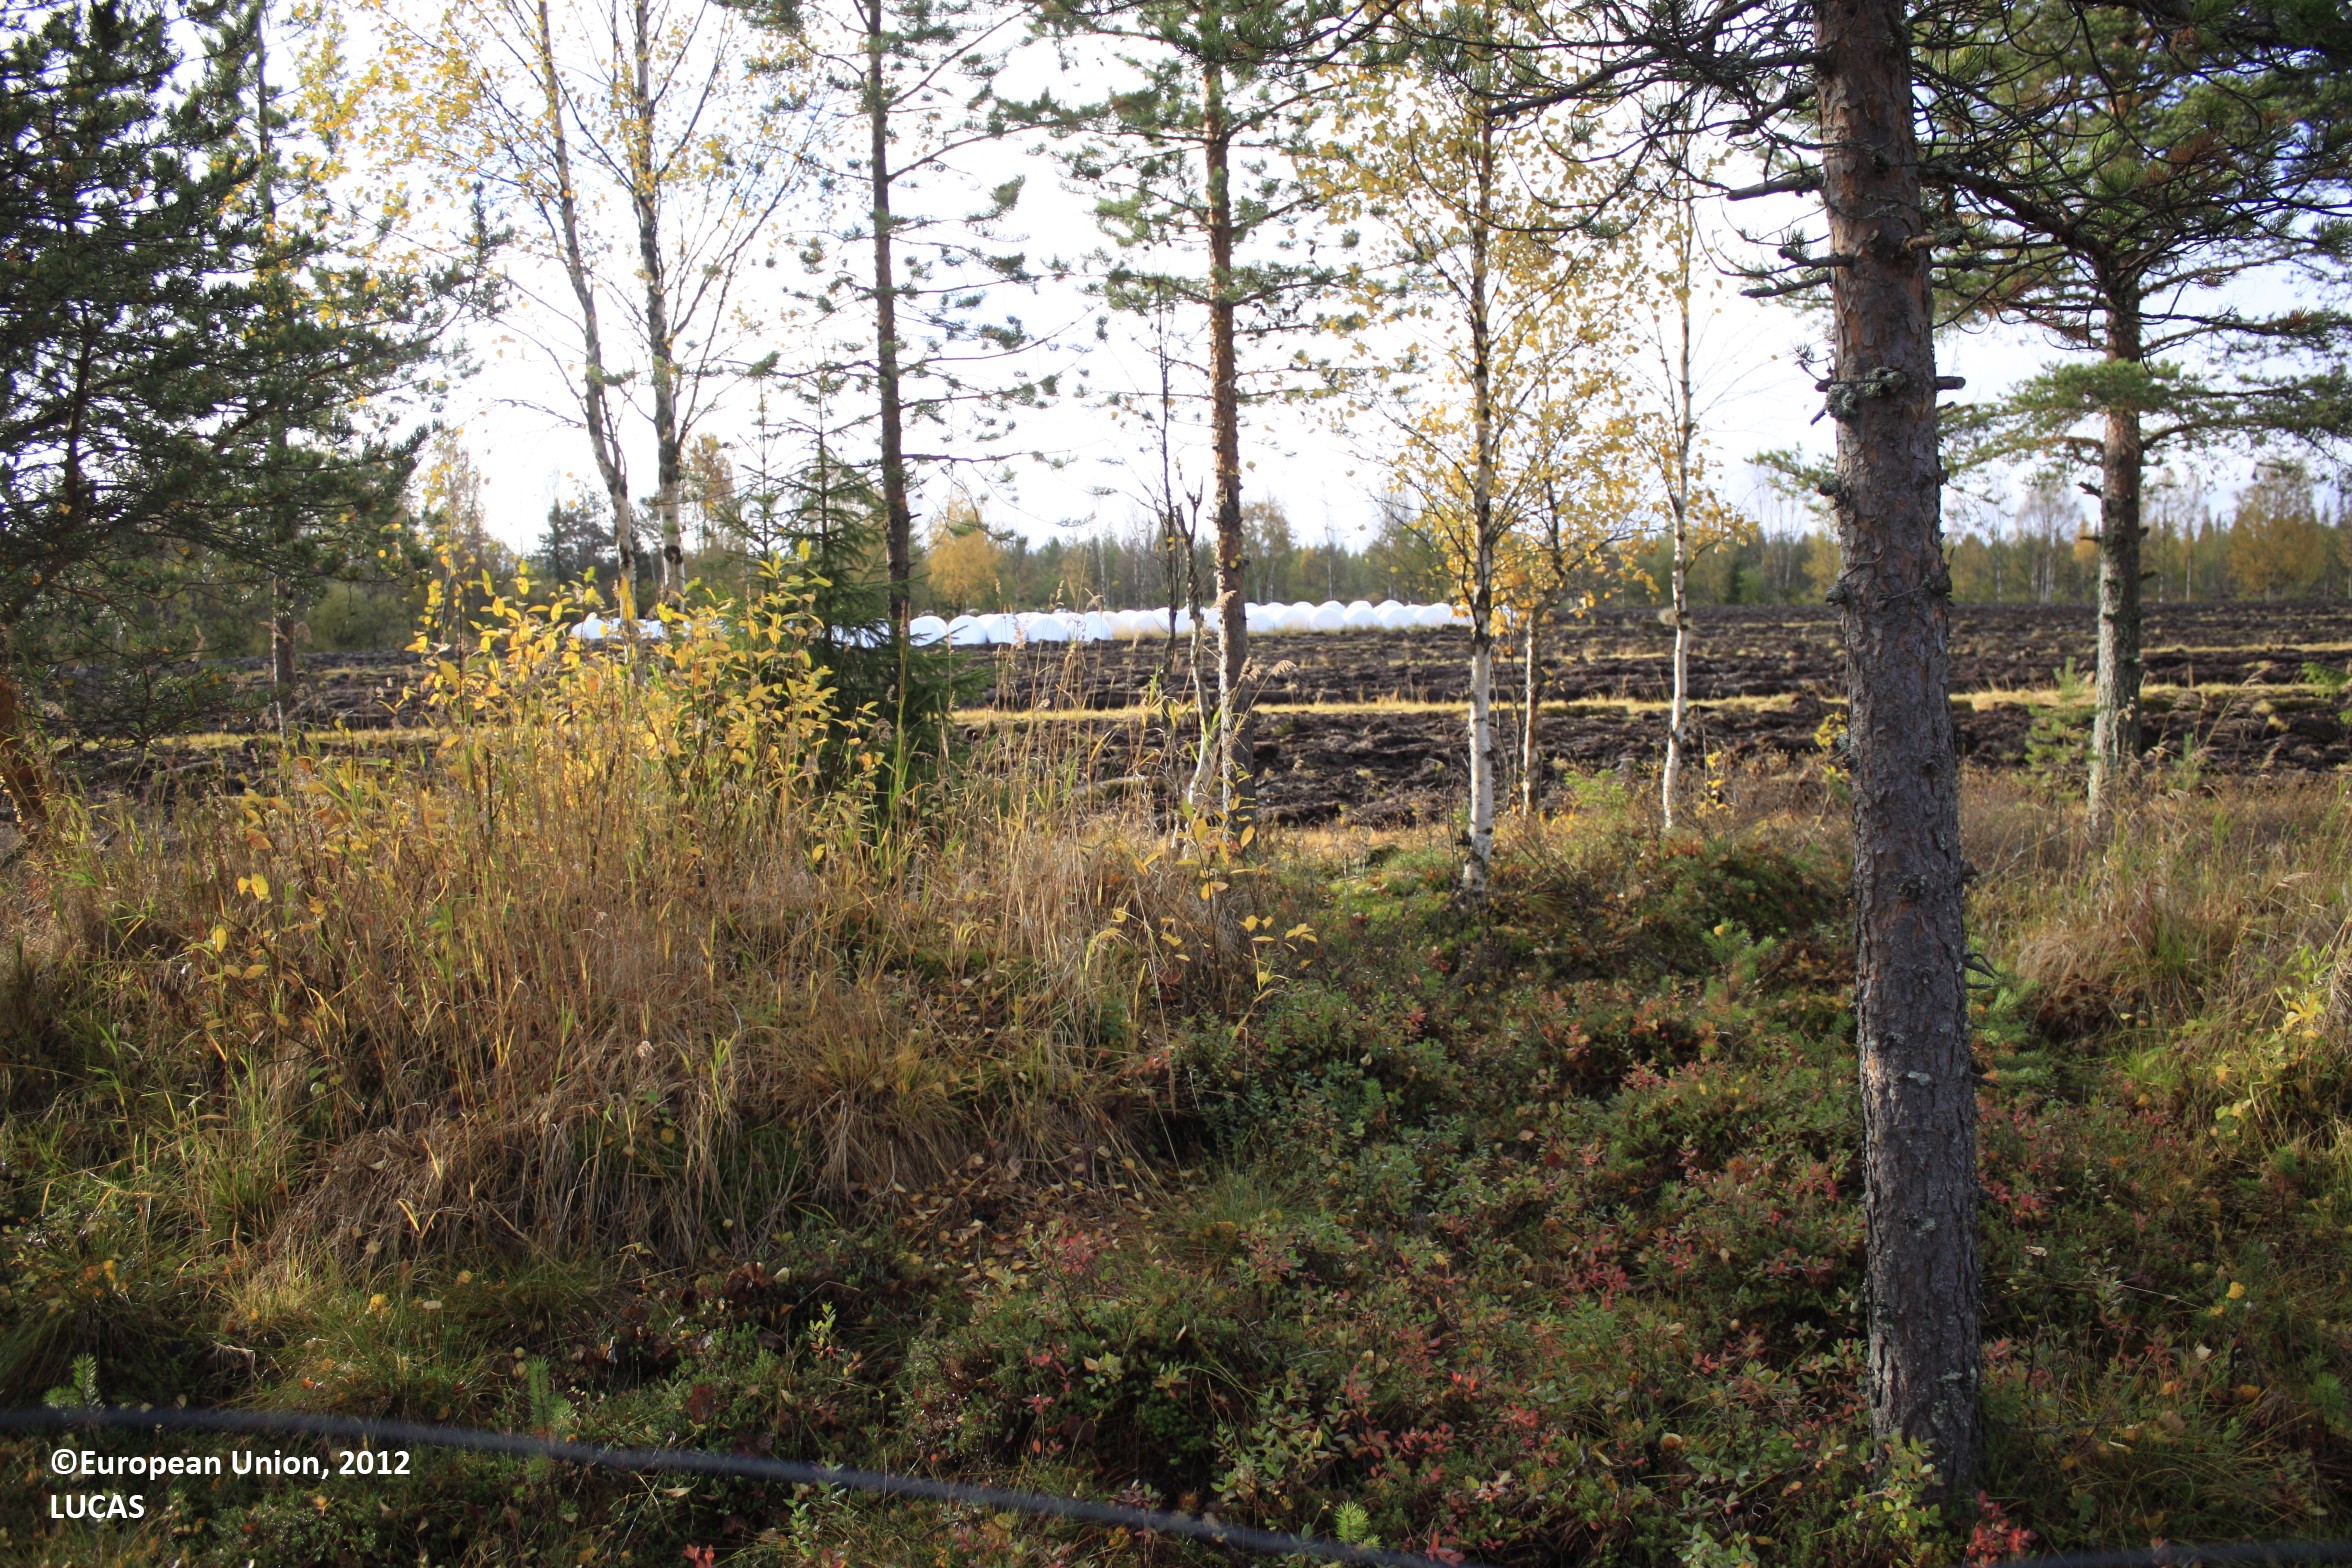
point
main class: Grassland
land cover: Grassland without tree/shrub cover
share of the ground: 25 - 50 %
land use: Agriculture (excluding fallow land and kitchen gardens)
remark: Tilled/Sowed
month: September
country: FI
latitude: 66.0336
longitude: 26.8483
